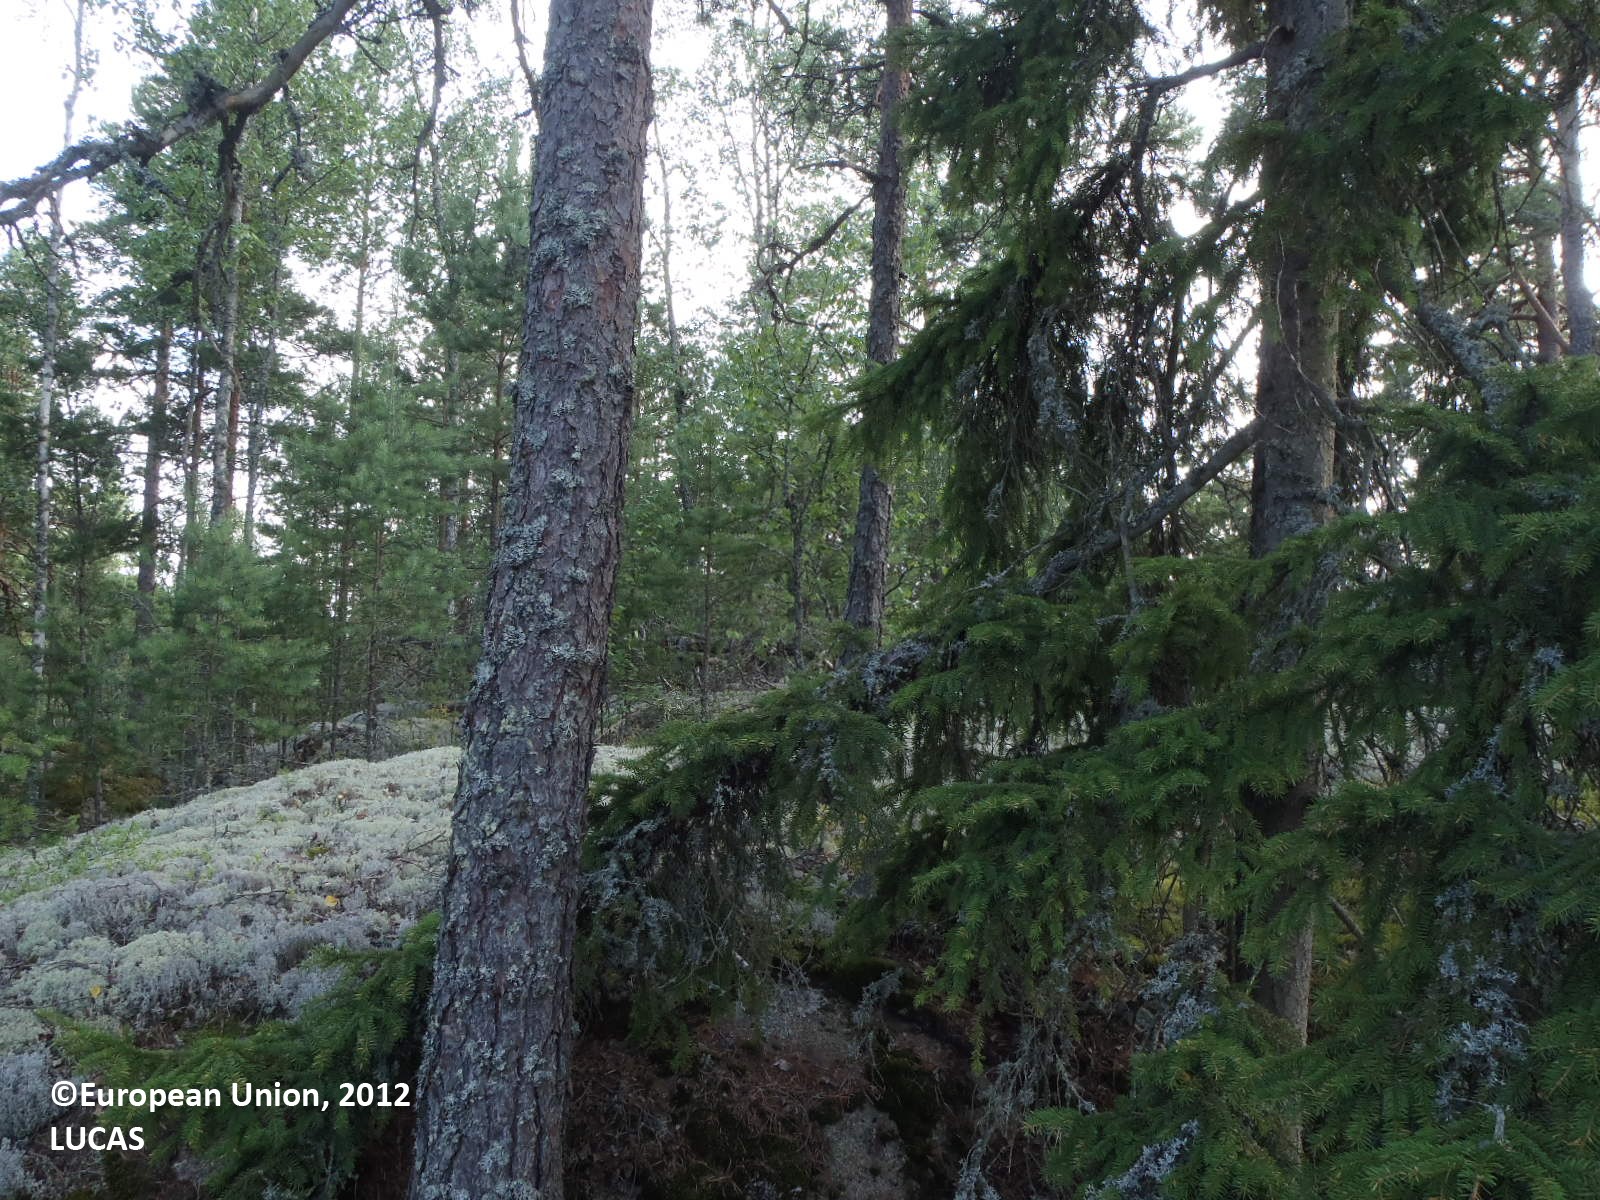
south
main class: Woodland
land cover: Pine dominated coniferous woodland
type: boreal forest
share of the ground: 50 - 75 %
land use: Semi-natural and natural areas not in use
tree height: > 5 m
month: July
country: FI
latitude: 60.5509
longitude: 21.6737
